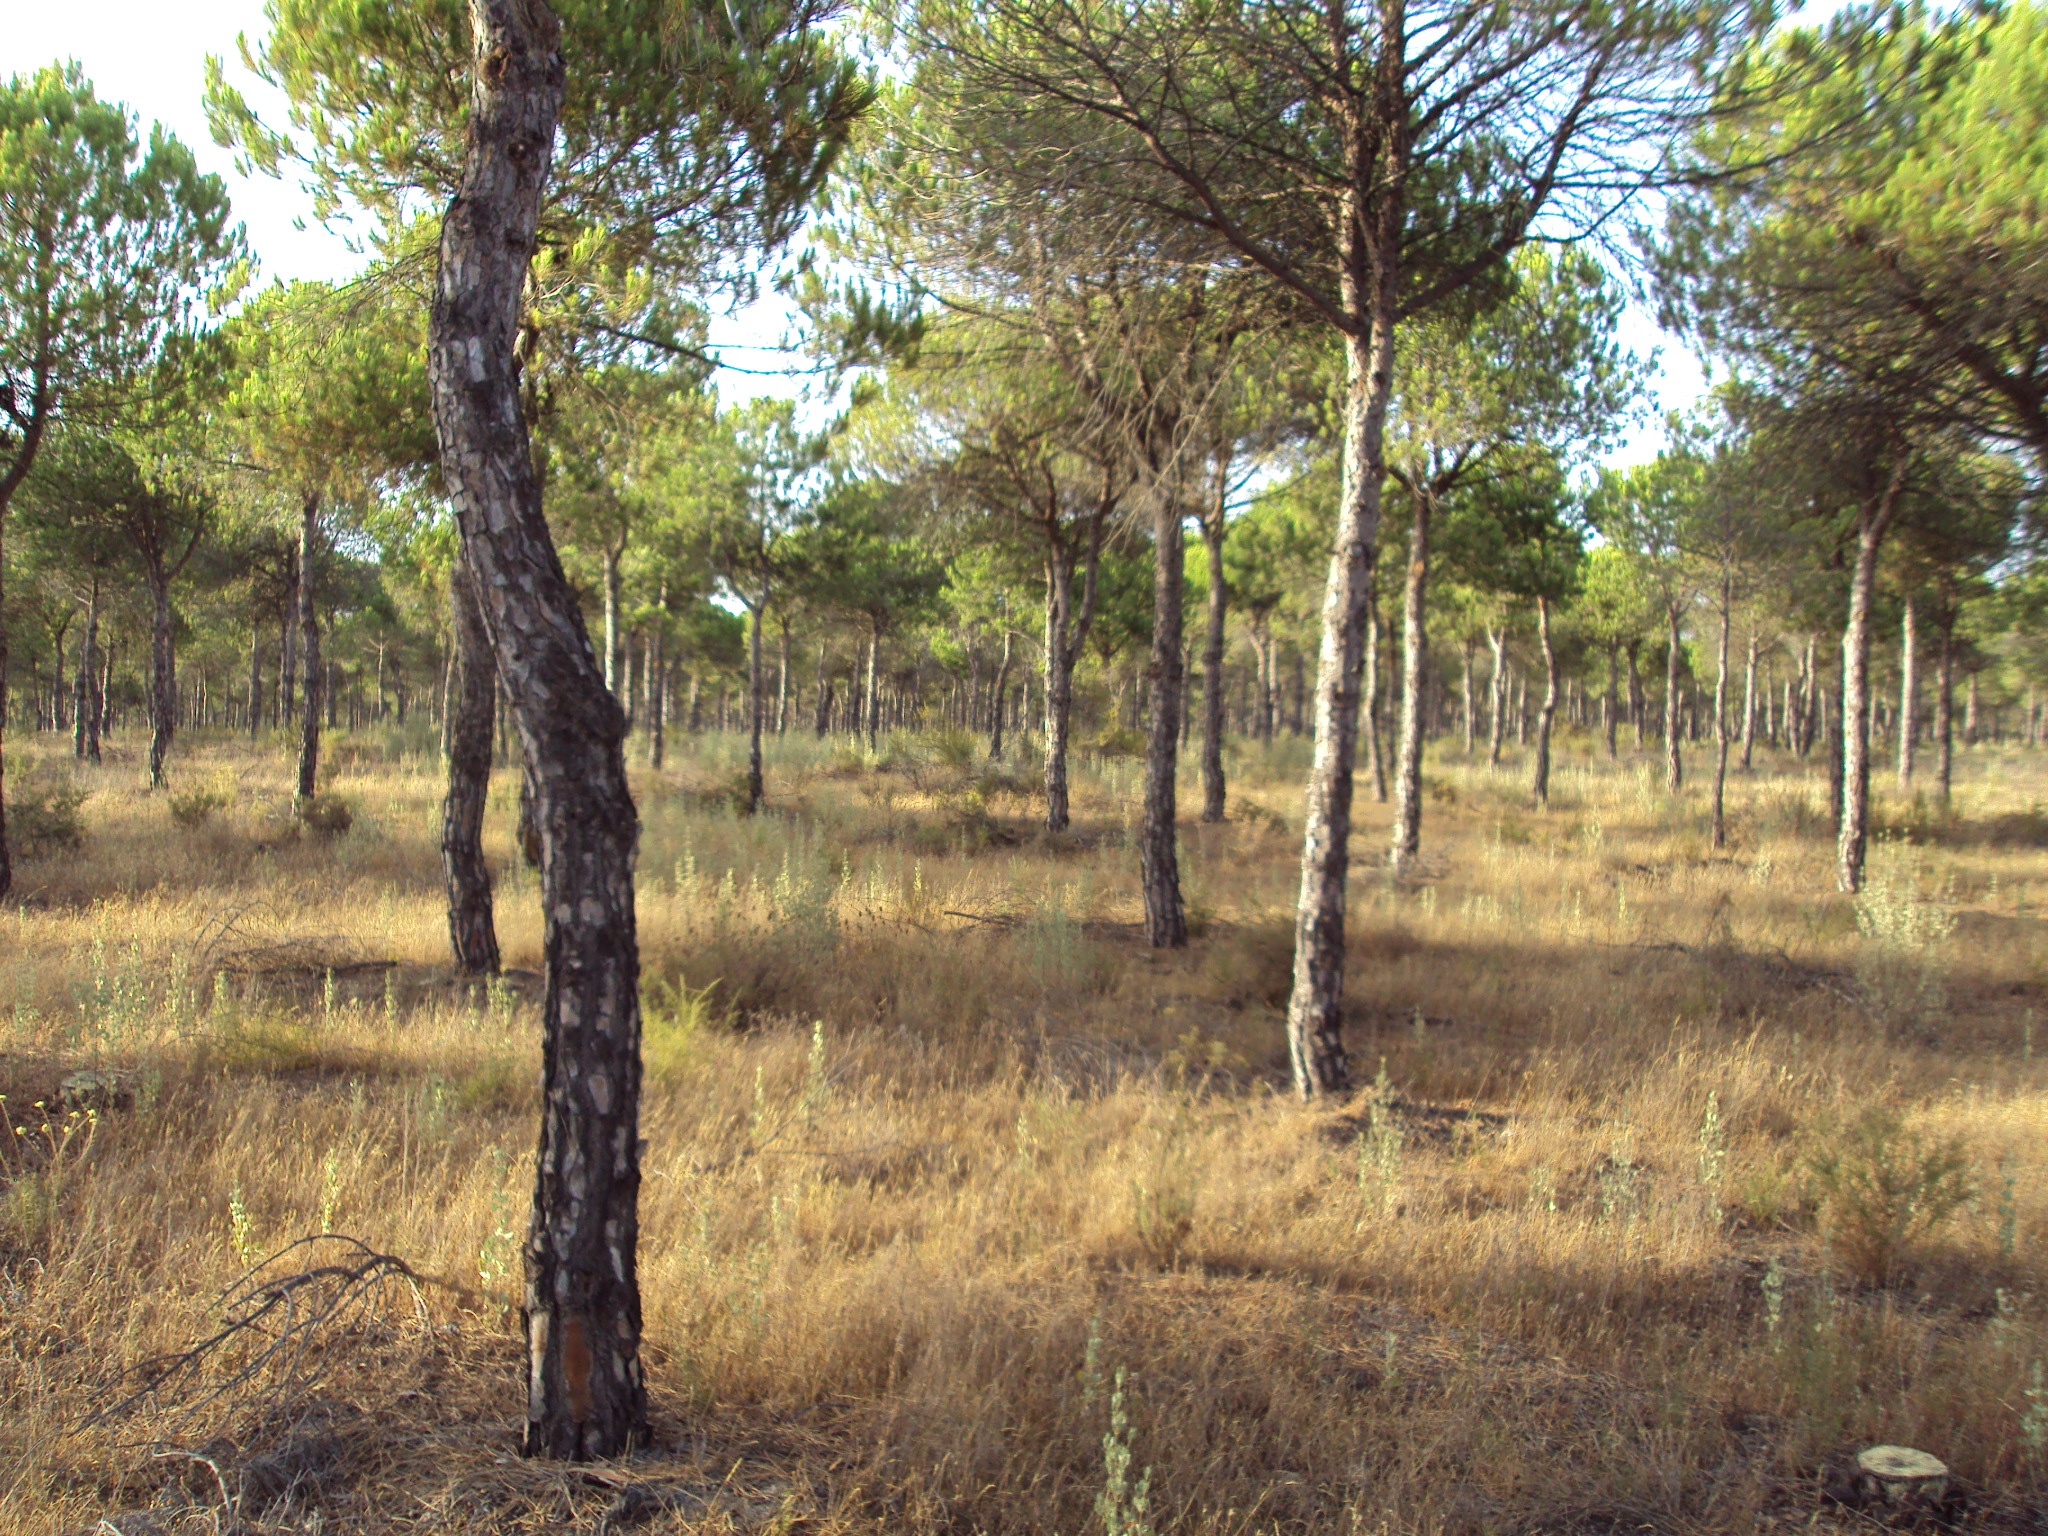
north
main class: Woodland
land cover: Pine dominated coniferous woodland
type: coniferous forest of the mediterranean region
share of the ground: 50 - 75 %
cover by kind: coniferous forest trees 60 %, shrubs 20 %, herbaceous plants 20 %
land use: Forestry
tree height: > 5 m
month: July
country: ES
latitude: 37.1429
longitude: -6.8193
